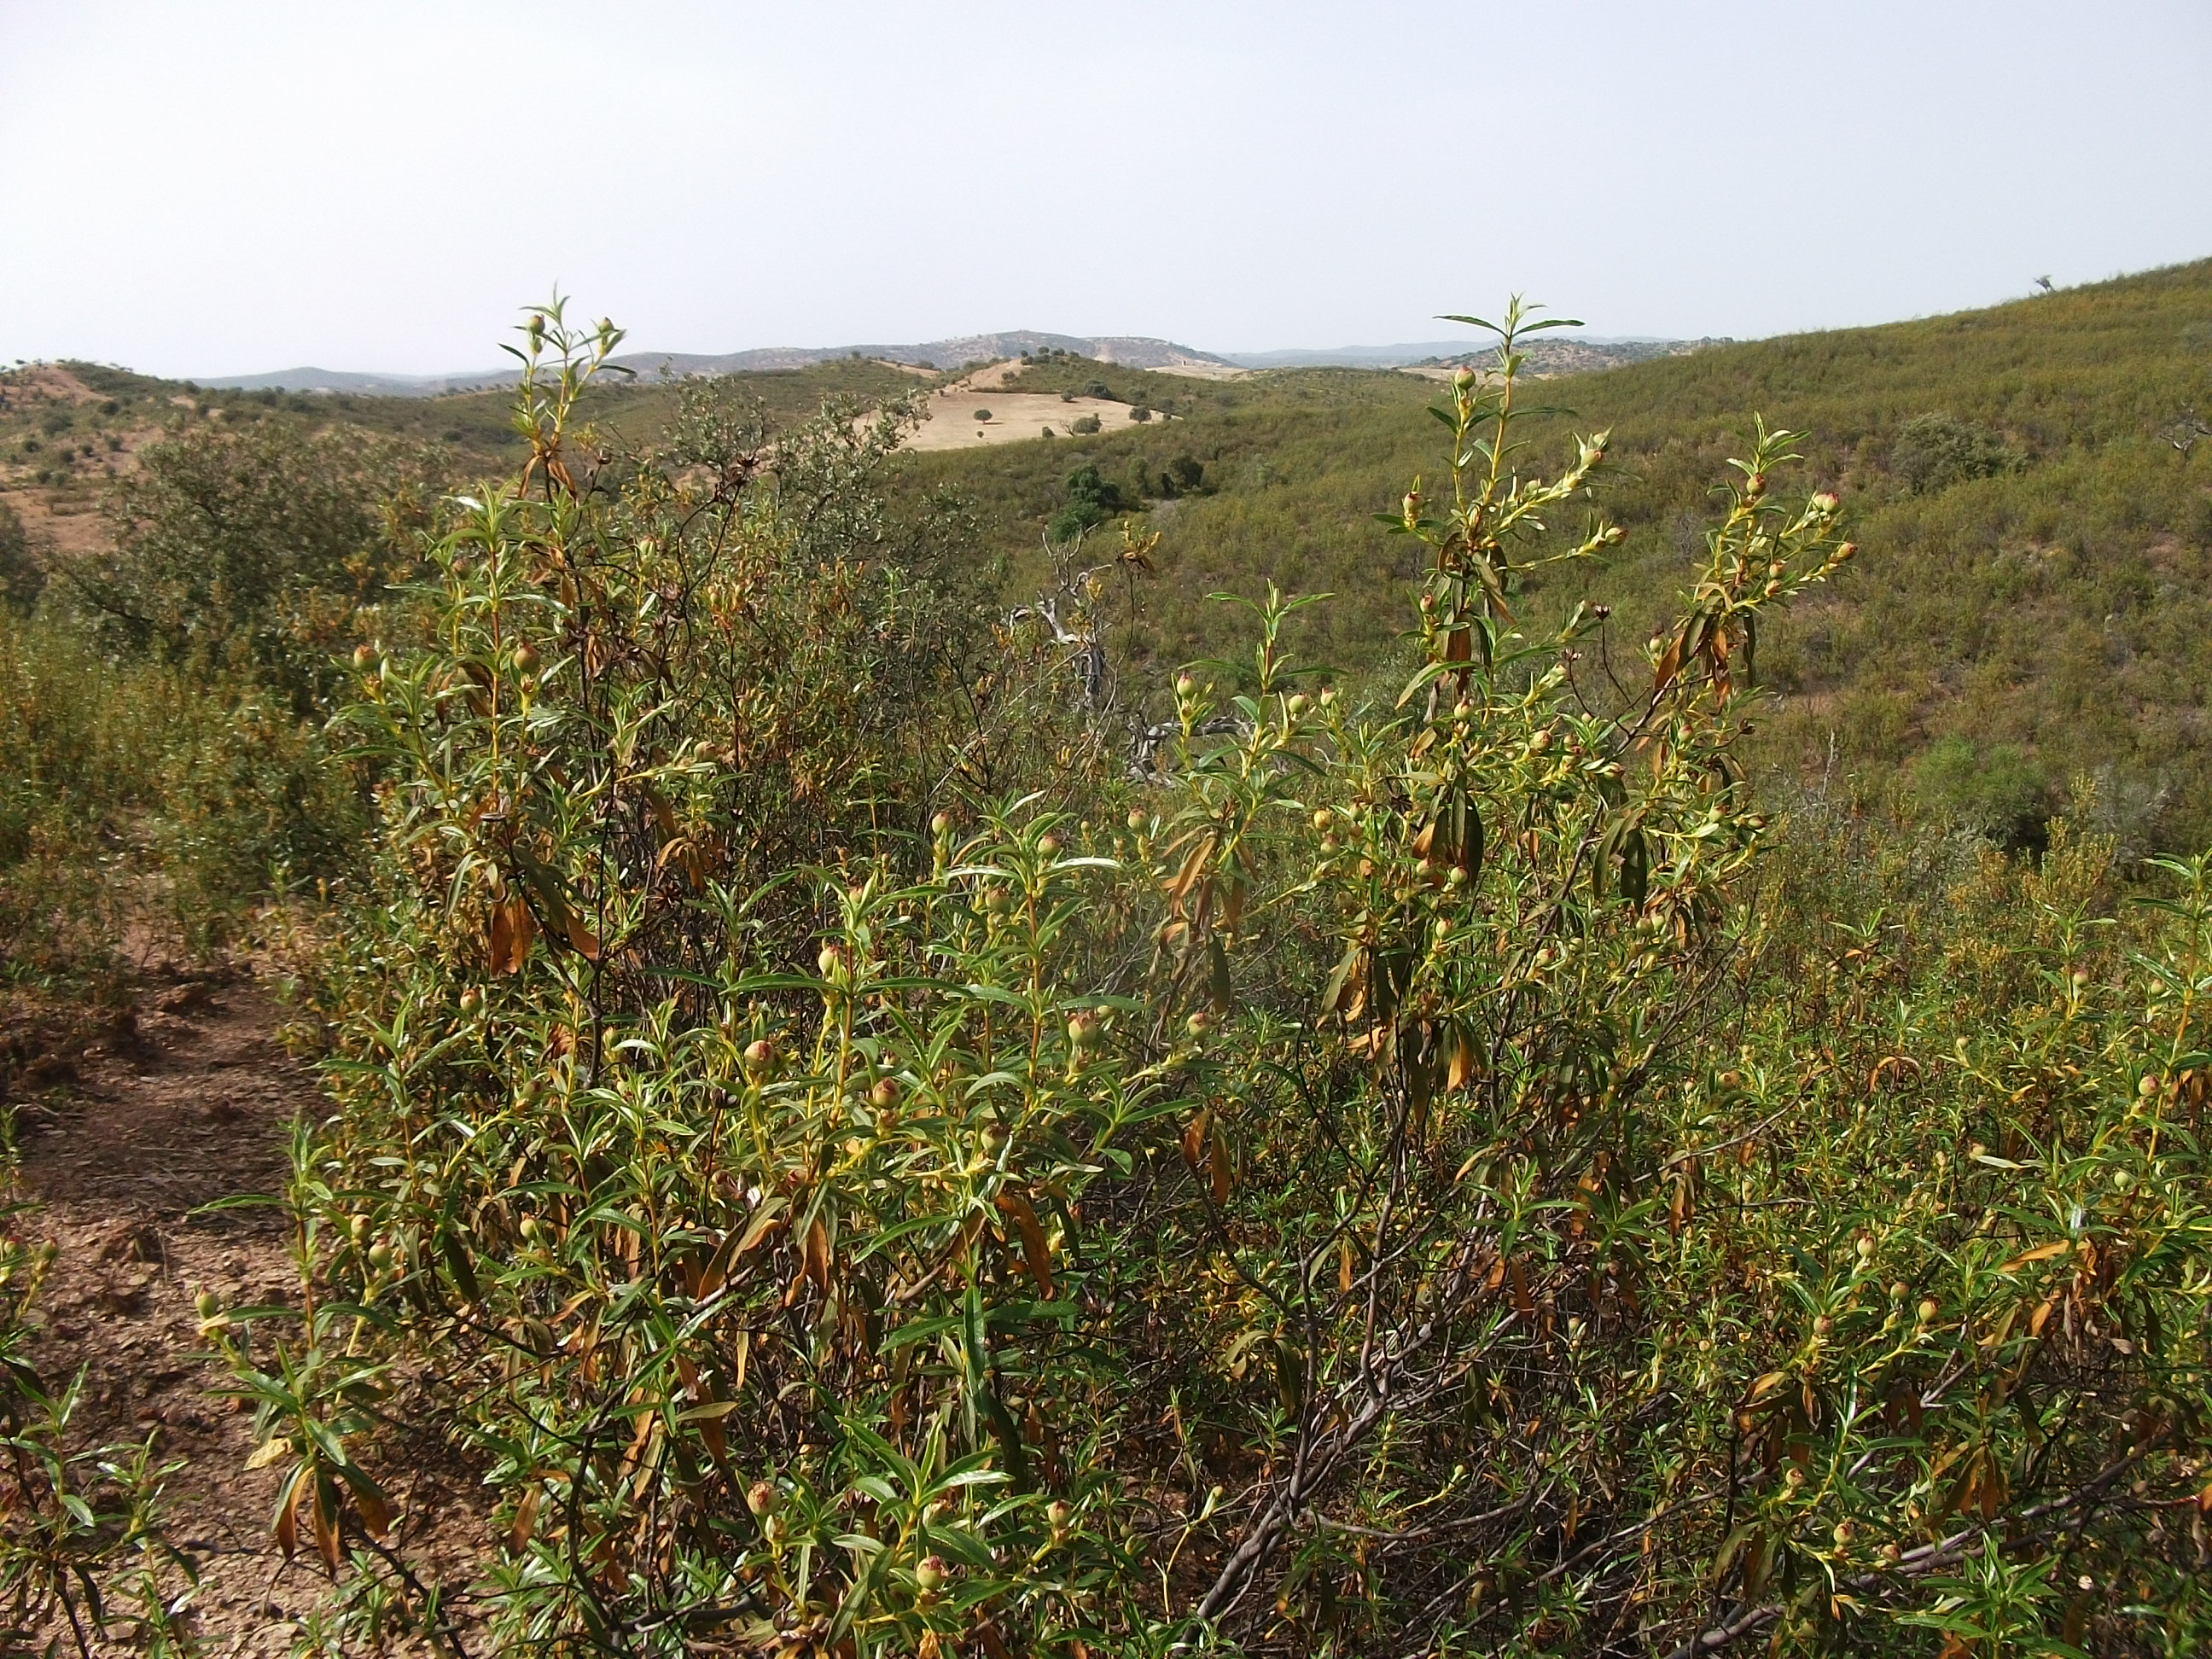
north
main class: Woodland
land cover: Broadleaved woodland
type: broadleaved evergreen forest
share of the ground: 10 - 25 %
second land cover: Spontaneously vegetated surfaces
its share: > 75 %
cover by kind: shrubs 90 %, broadleaved forest trees 10 %
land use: Agriculture (excluding fallow land and kitchen gardens)
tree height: > 5 m
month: May
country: ES
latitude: 37.6826
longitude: -6.9999
